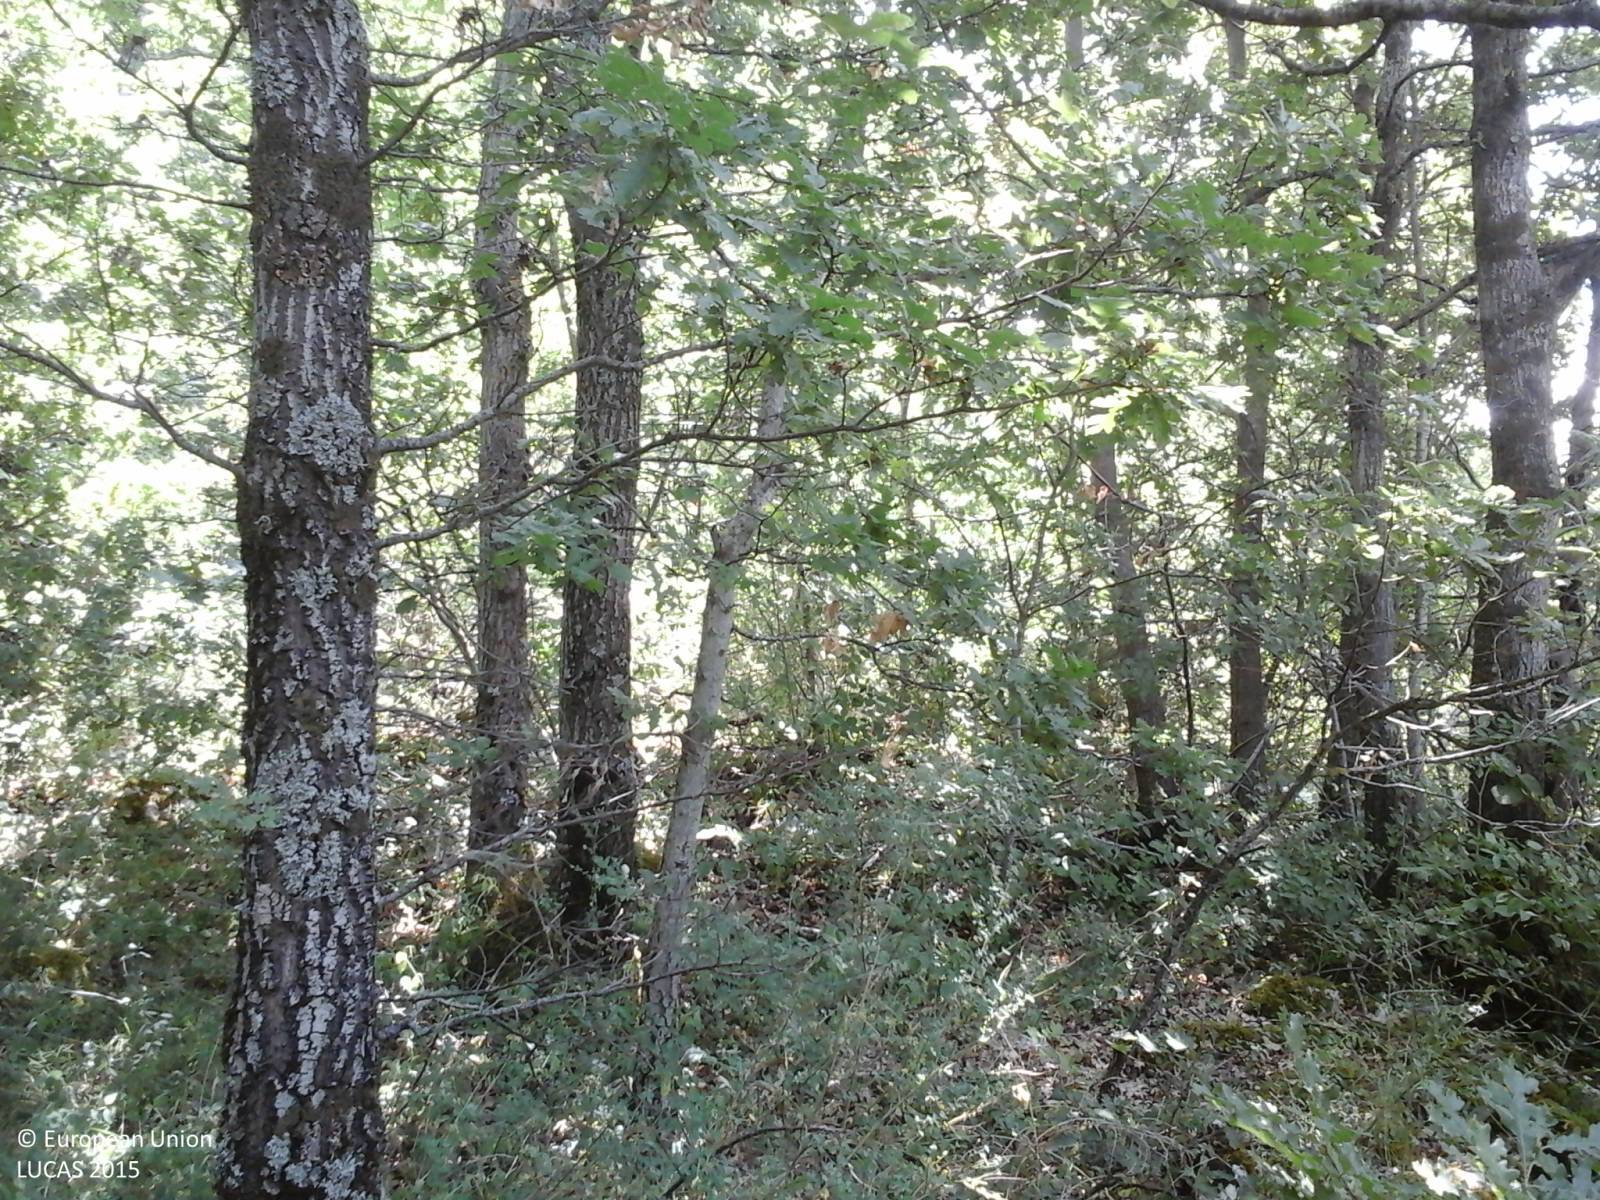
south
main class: Woodland
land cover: Broadleaved woodland
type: thermophilous deciduous forest
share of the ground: > 75 %
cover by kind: broadleaved forest trees 100 %
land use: Forestry
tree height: > 5 m
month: July
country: IT
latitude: 42.4397
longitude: 13.2355
